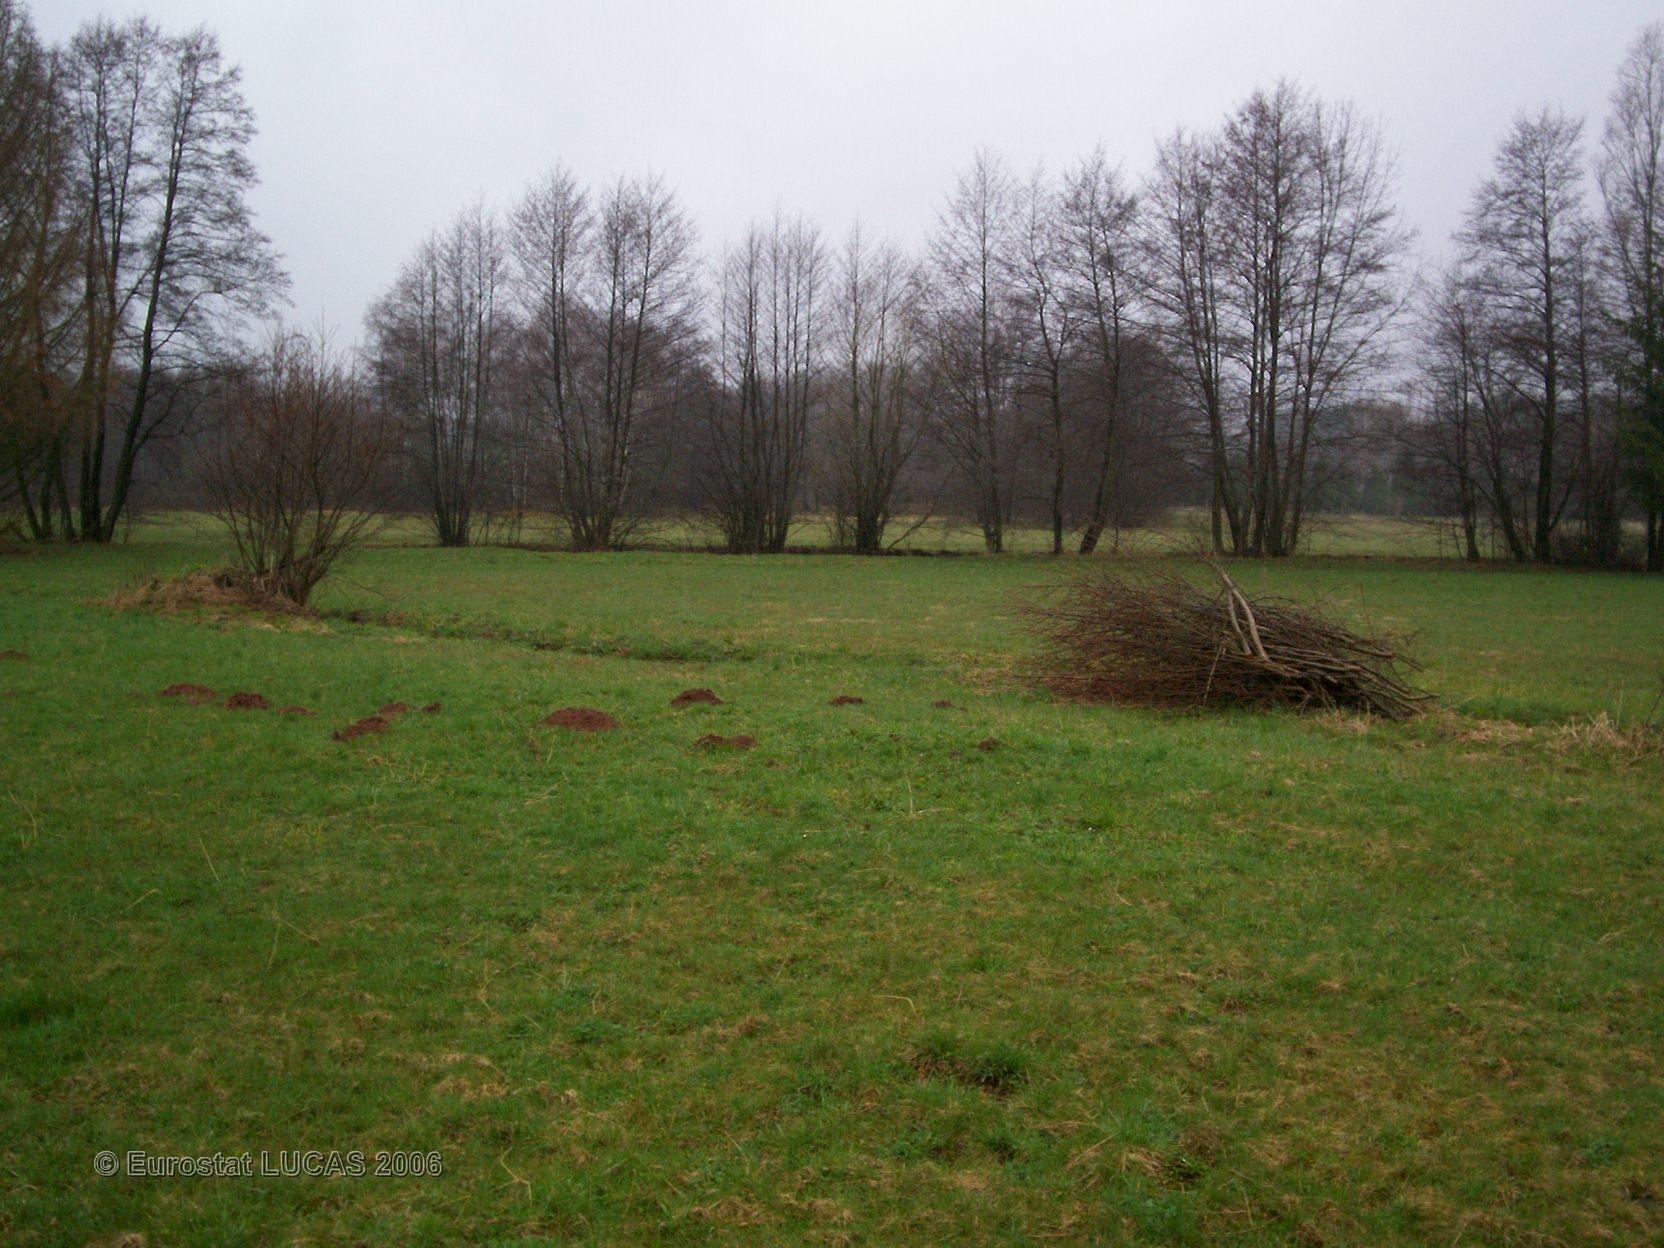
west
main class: Grassland
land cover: Grassland without tree/shrub cover
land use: Agriculture (excluding fallow land and kitchen gardens)
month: April
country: FR
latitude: 47.7093
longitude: 6.8160
